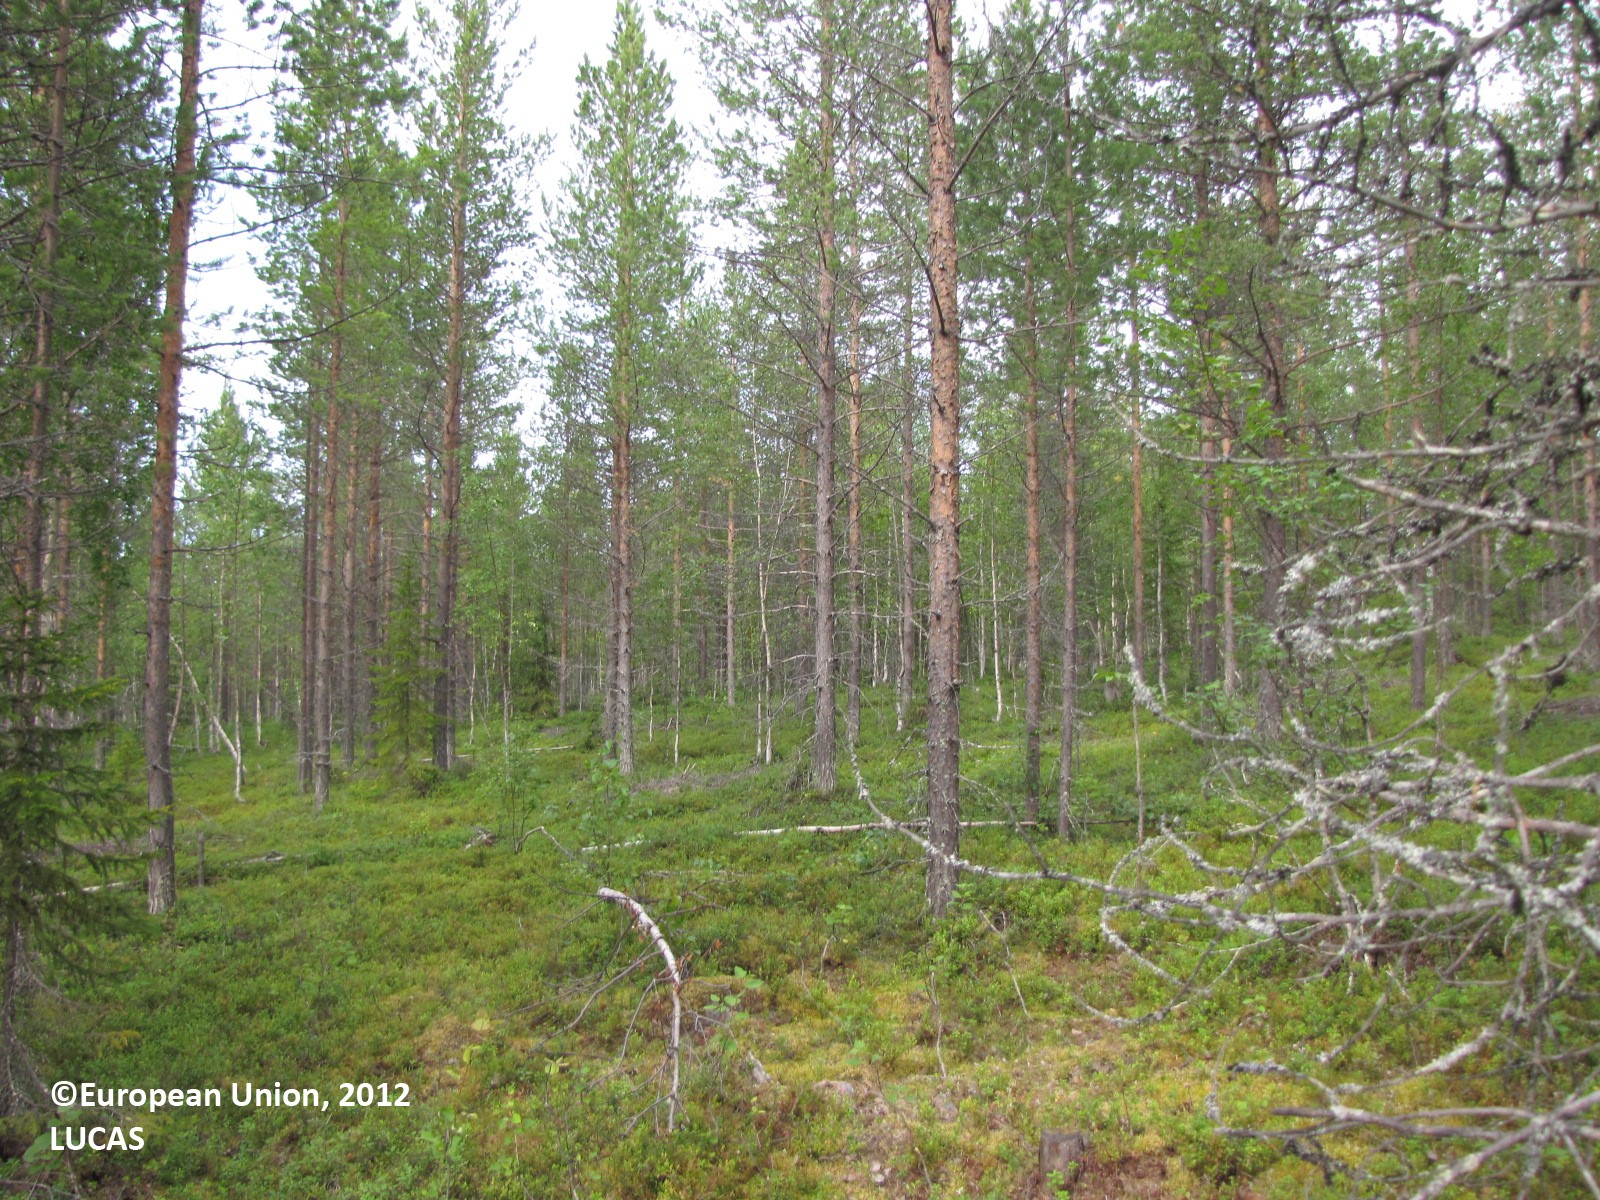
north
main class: Woodland
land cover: Pine dominated mixed woodland
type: boreal forest
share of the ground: 25 - 50 %
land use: Forestry
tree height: > 5 m
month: August
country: FI
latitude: 66.8645
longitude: 24.9411
